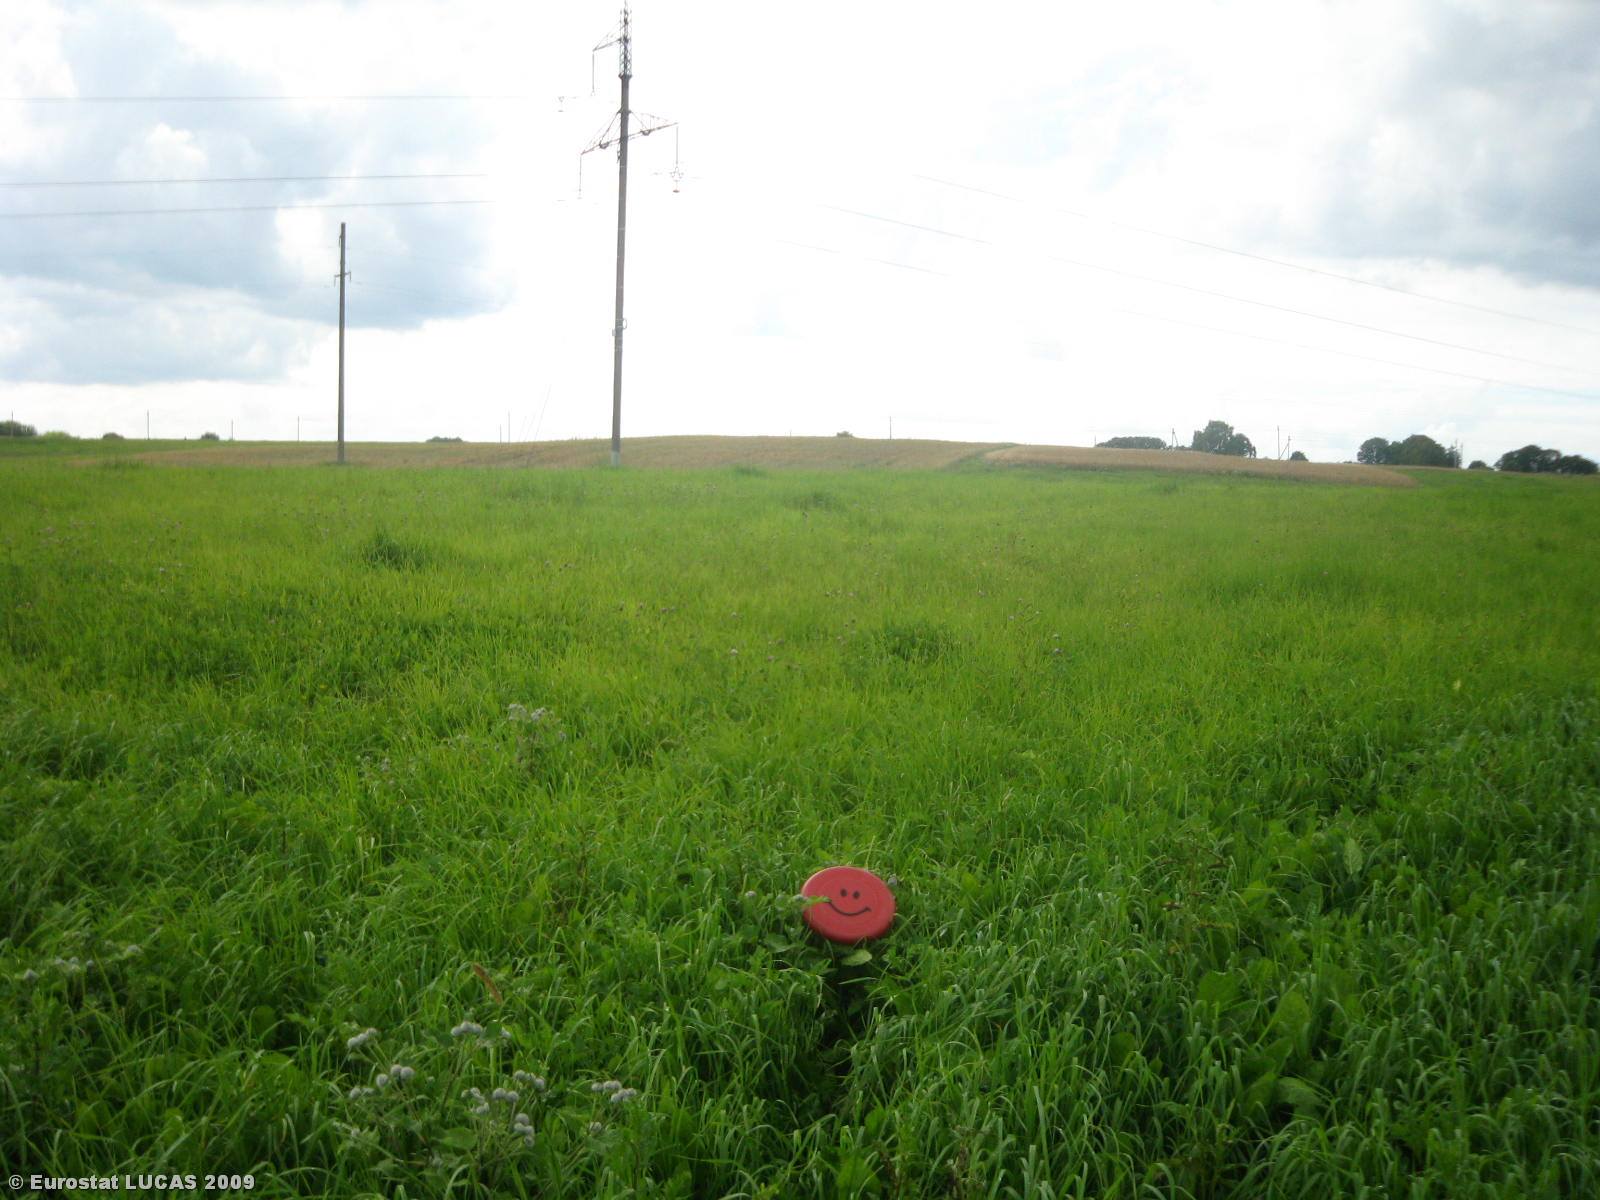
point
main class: Grassland
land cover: Grassland without tree/shrub cover
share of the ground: > 75 %
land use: Agriculture (excluding fallow land and kitchen gardens)
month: July
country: LT
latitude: 55.0615
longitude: 23.5623
